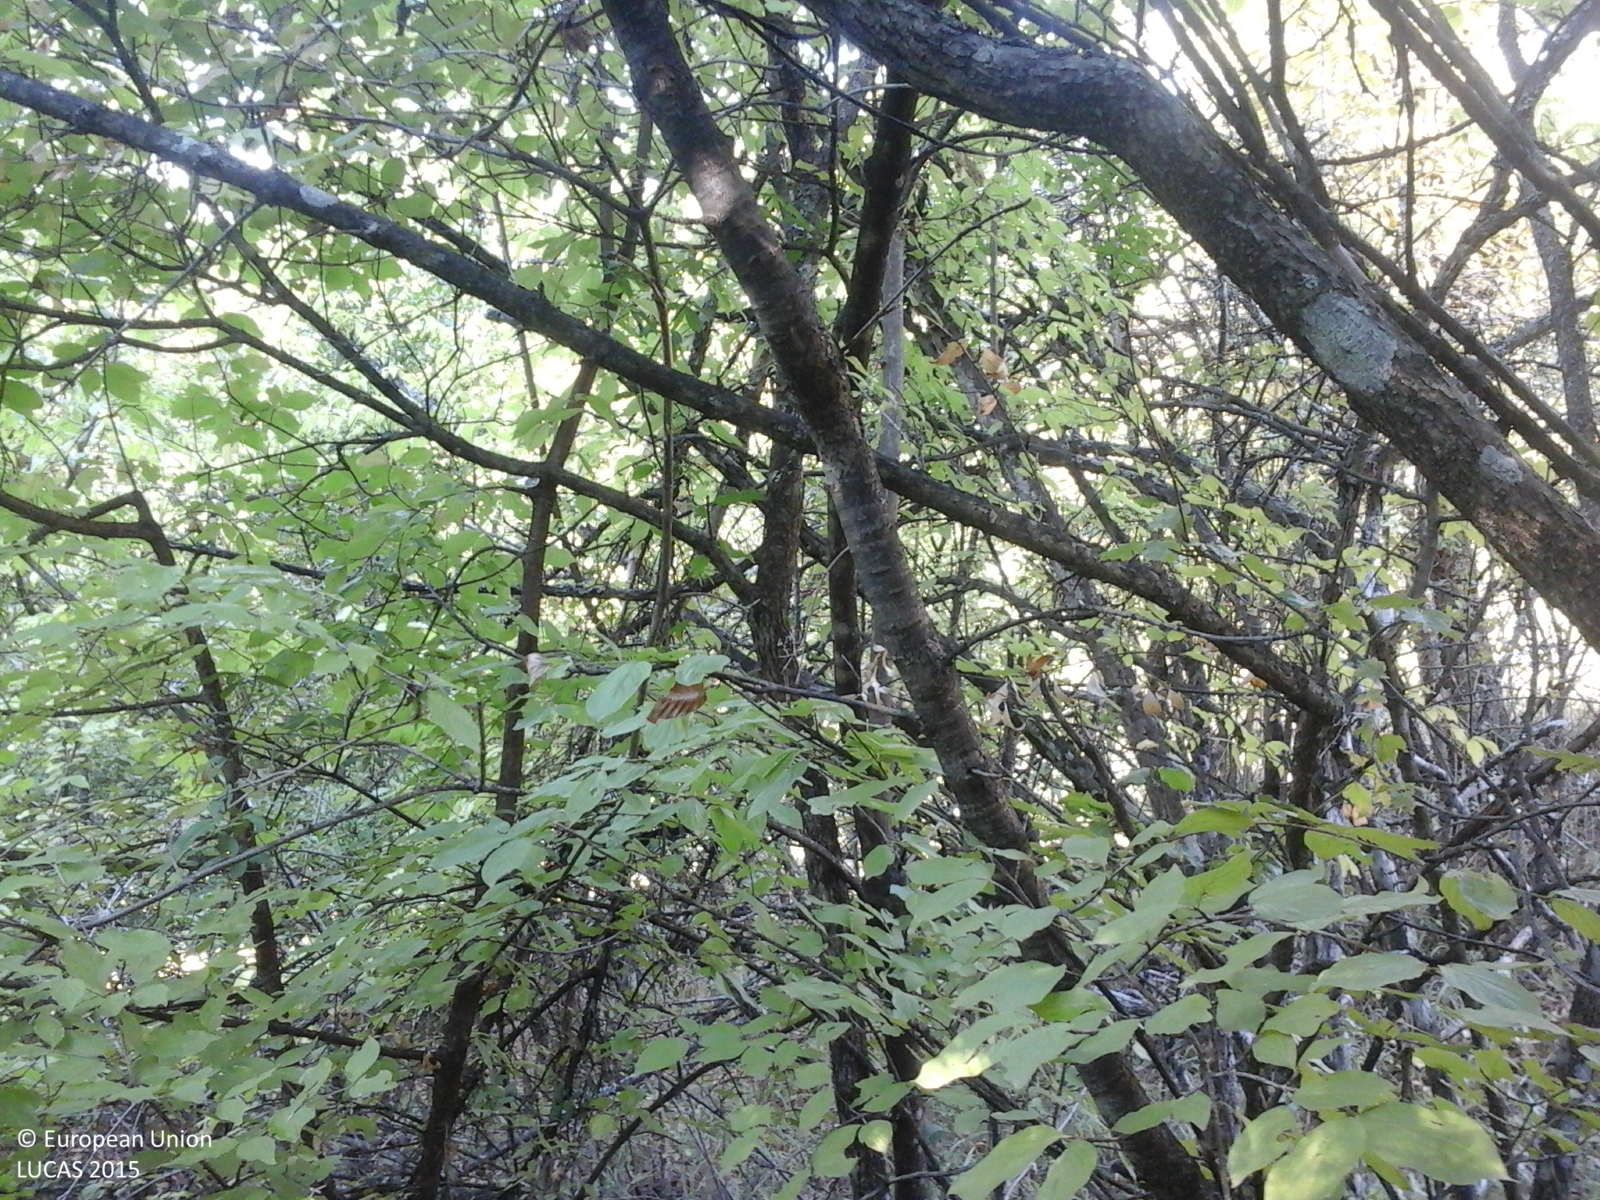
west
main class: Woodland
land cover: Broadleaved woodland
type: beech forest
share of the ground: > 75 %
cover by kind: broadleaved forest trees 100 %
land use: Forestry
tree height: > 5 m
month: September
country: RO
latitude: 47.3638
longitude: 23.4051
